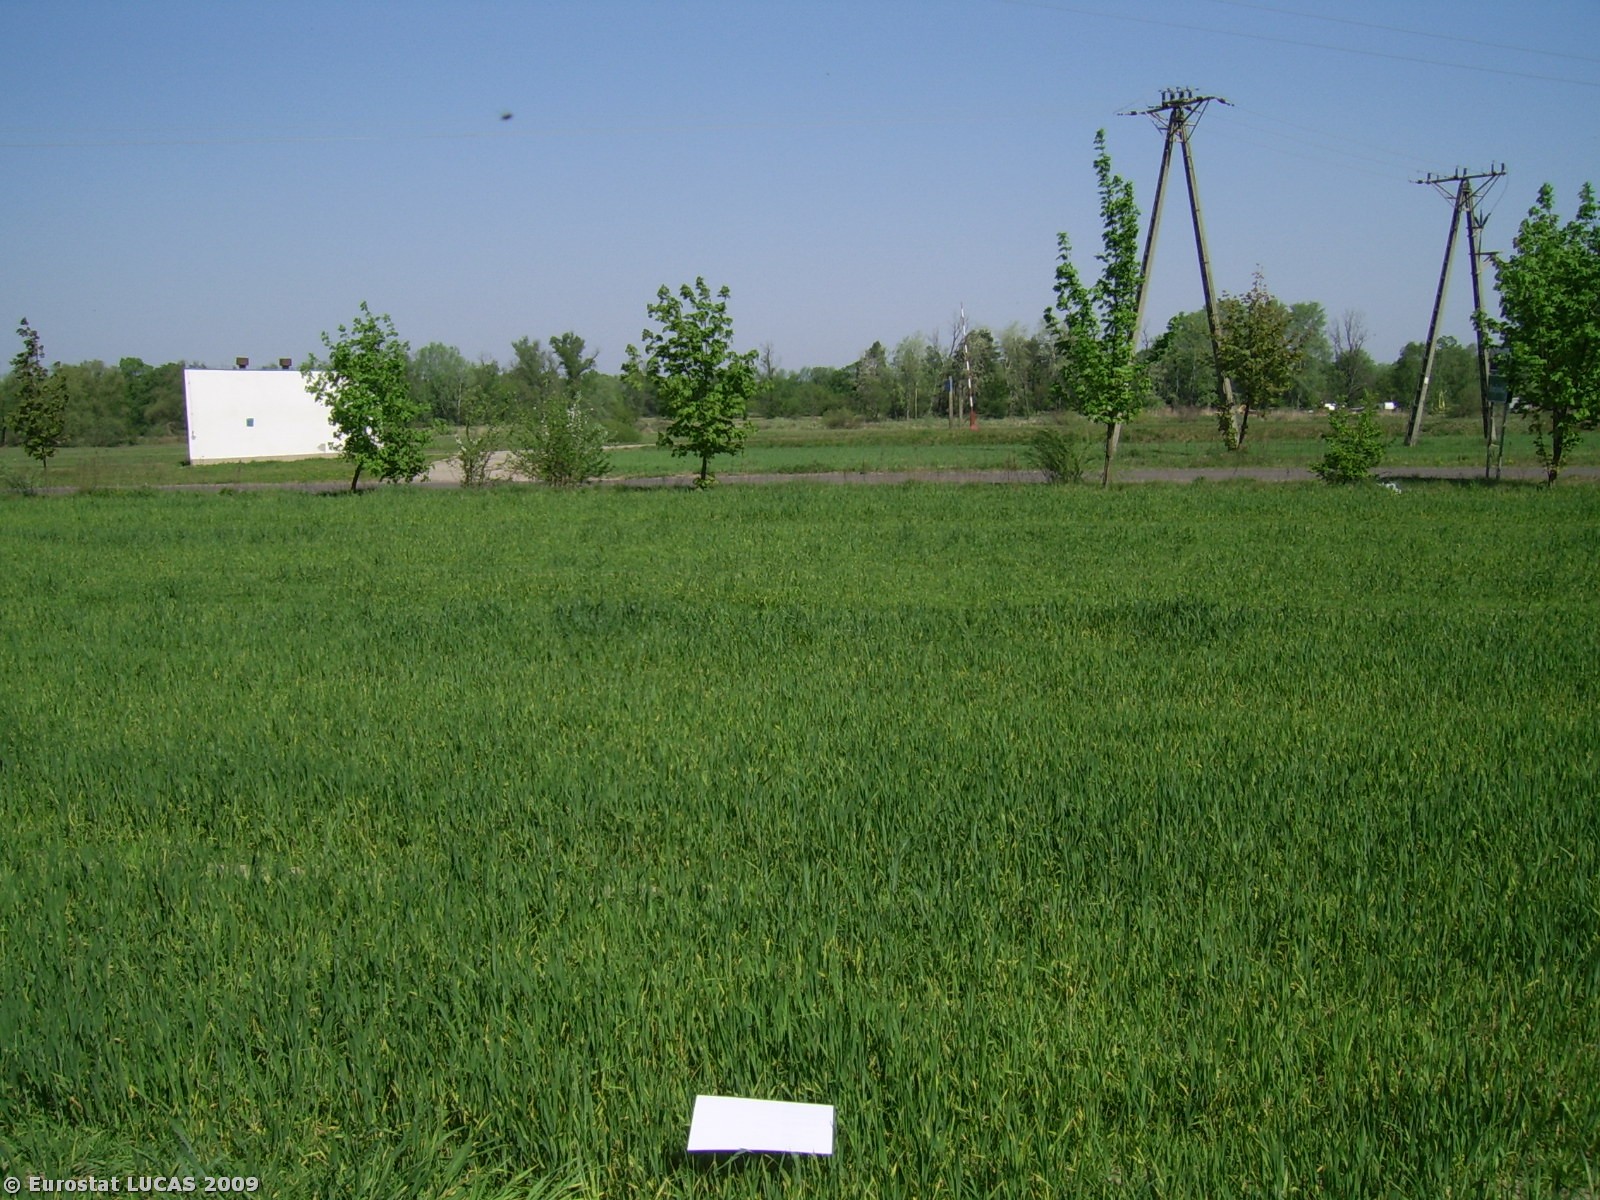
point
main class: Cropland
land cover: Common wheat
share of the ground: > 75 %
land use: Agriculture (excluding fallow land and kitchen gardens)
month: April
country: PL
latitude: 52.2109
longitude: 16.9318
